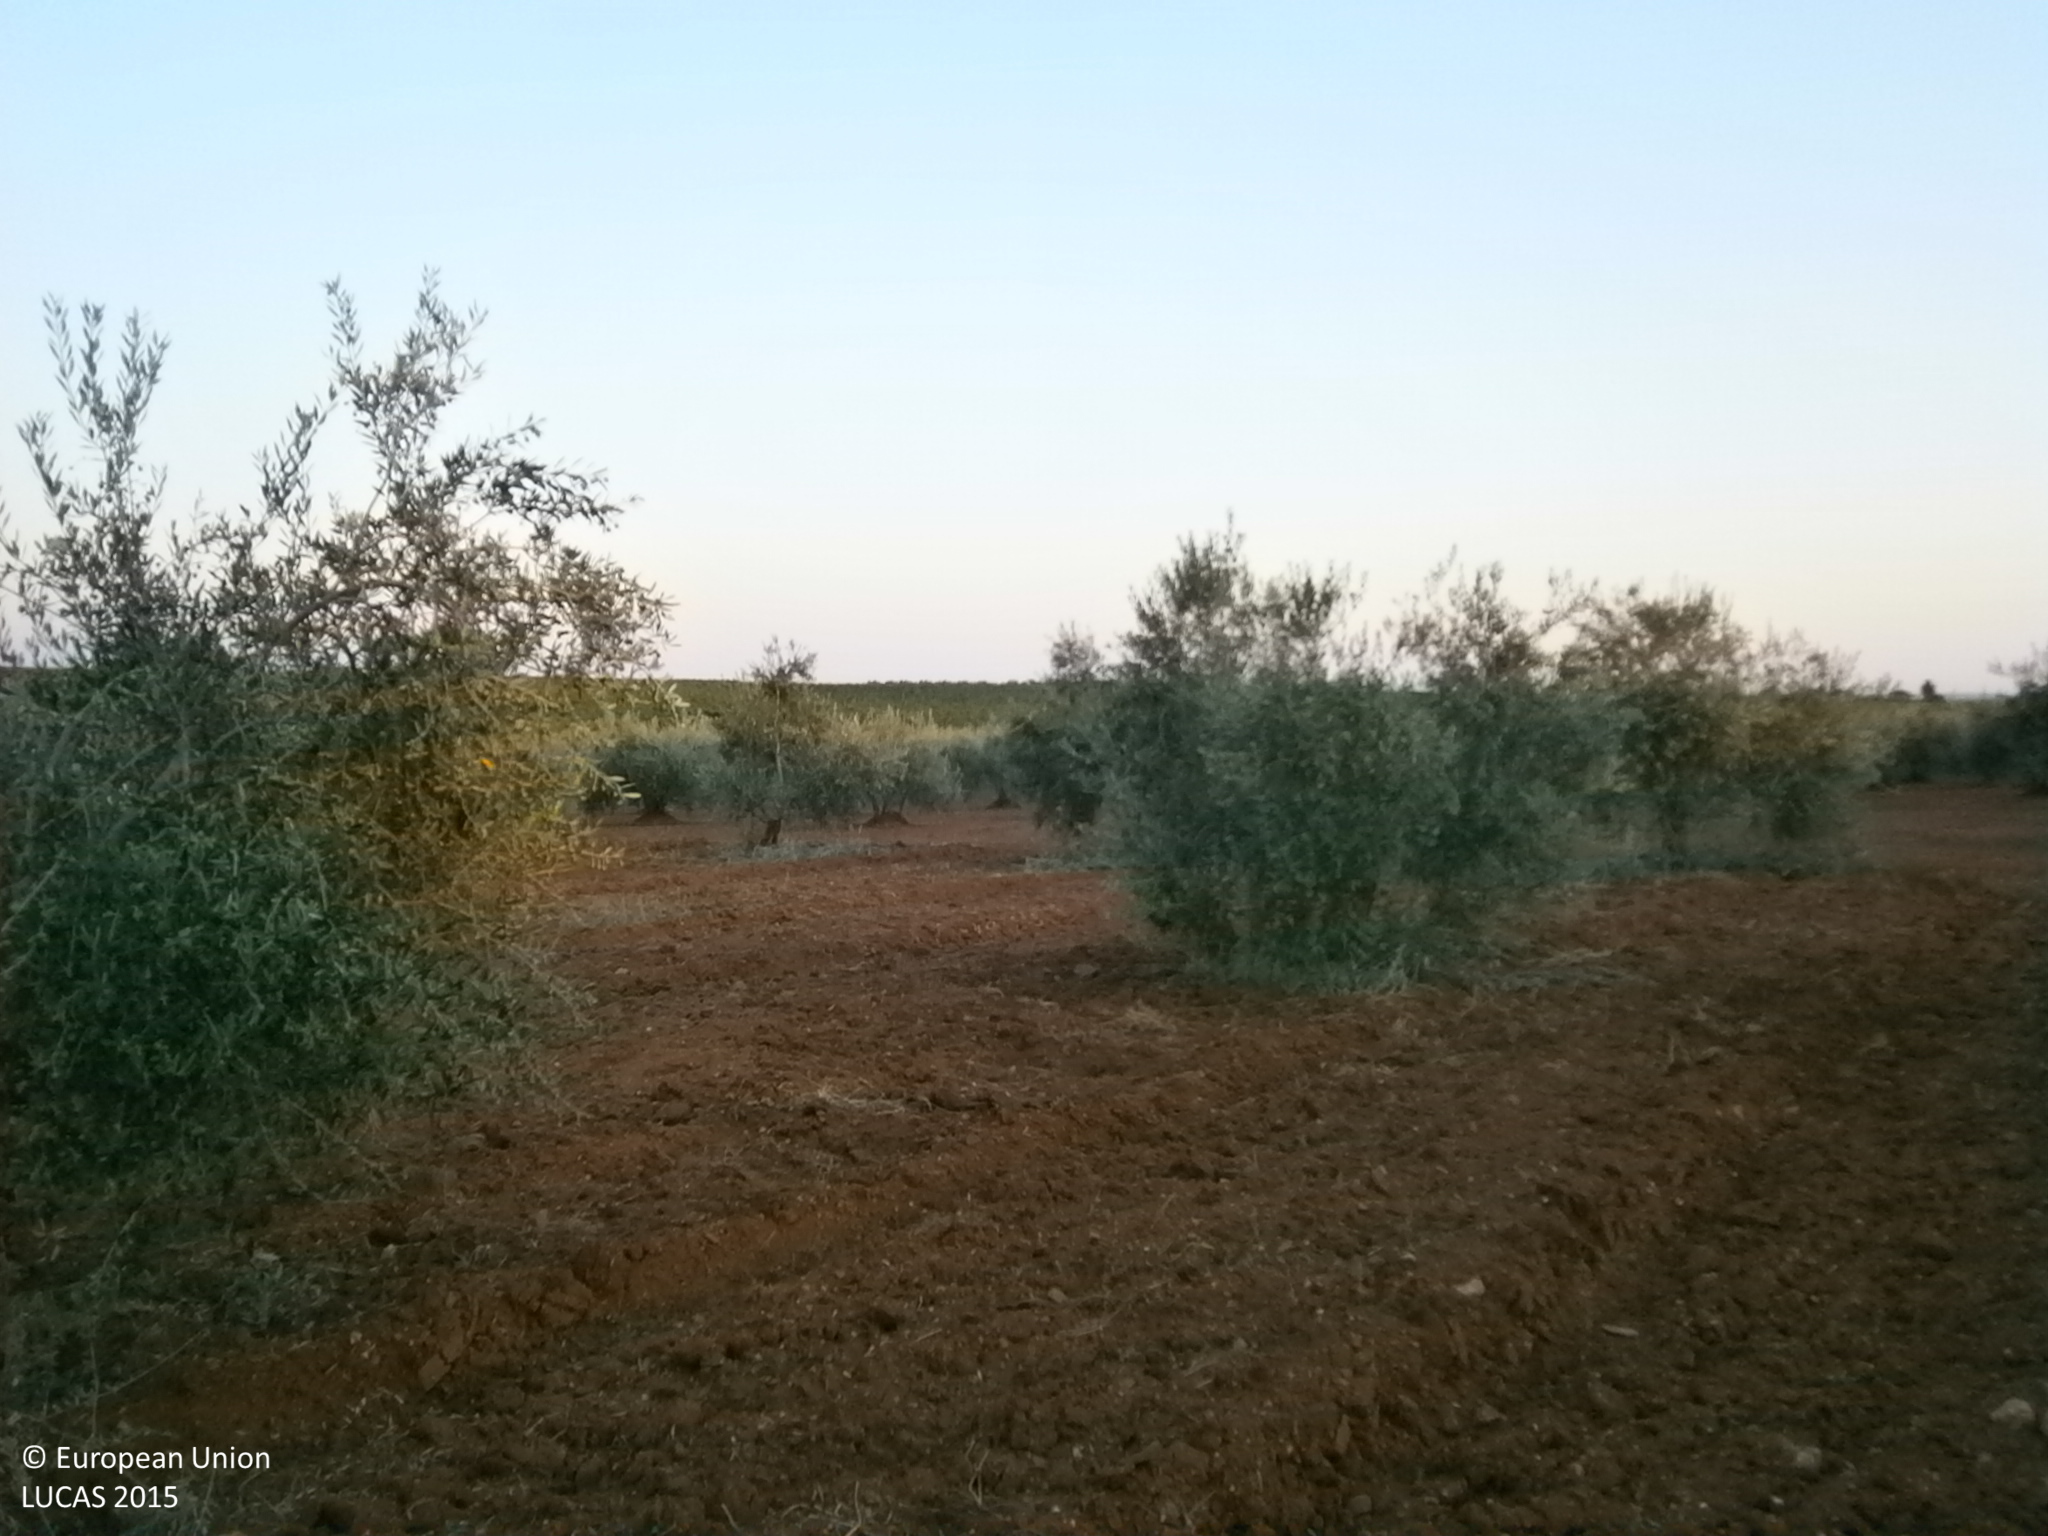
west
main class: Cropland
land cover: Olive groves
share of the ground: 25 - 50 %
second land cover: Other bare soil
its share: > 75 %
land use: Agriculture (excluding fallow land and kitchen gardens)
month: June
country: ES
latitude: 38.6253
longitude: -6.6799
